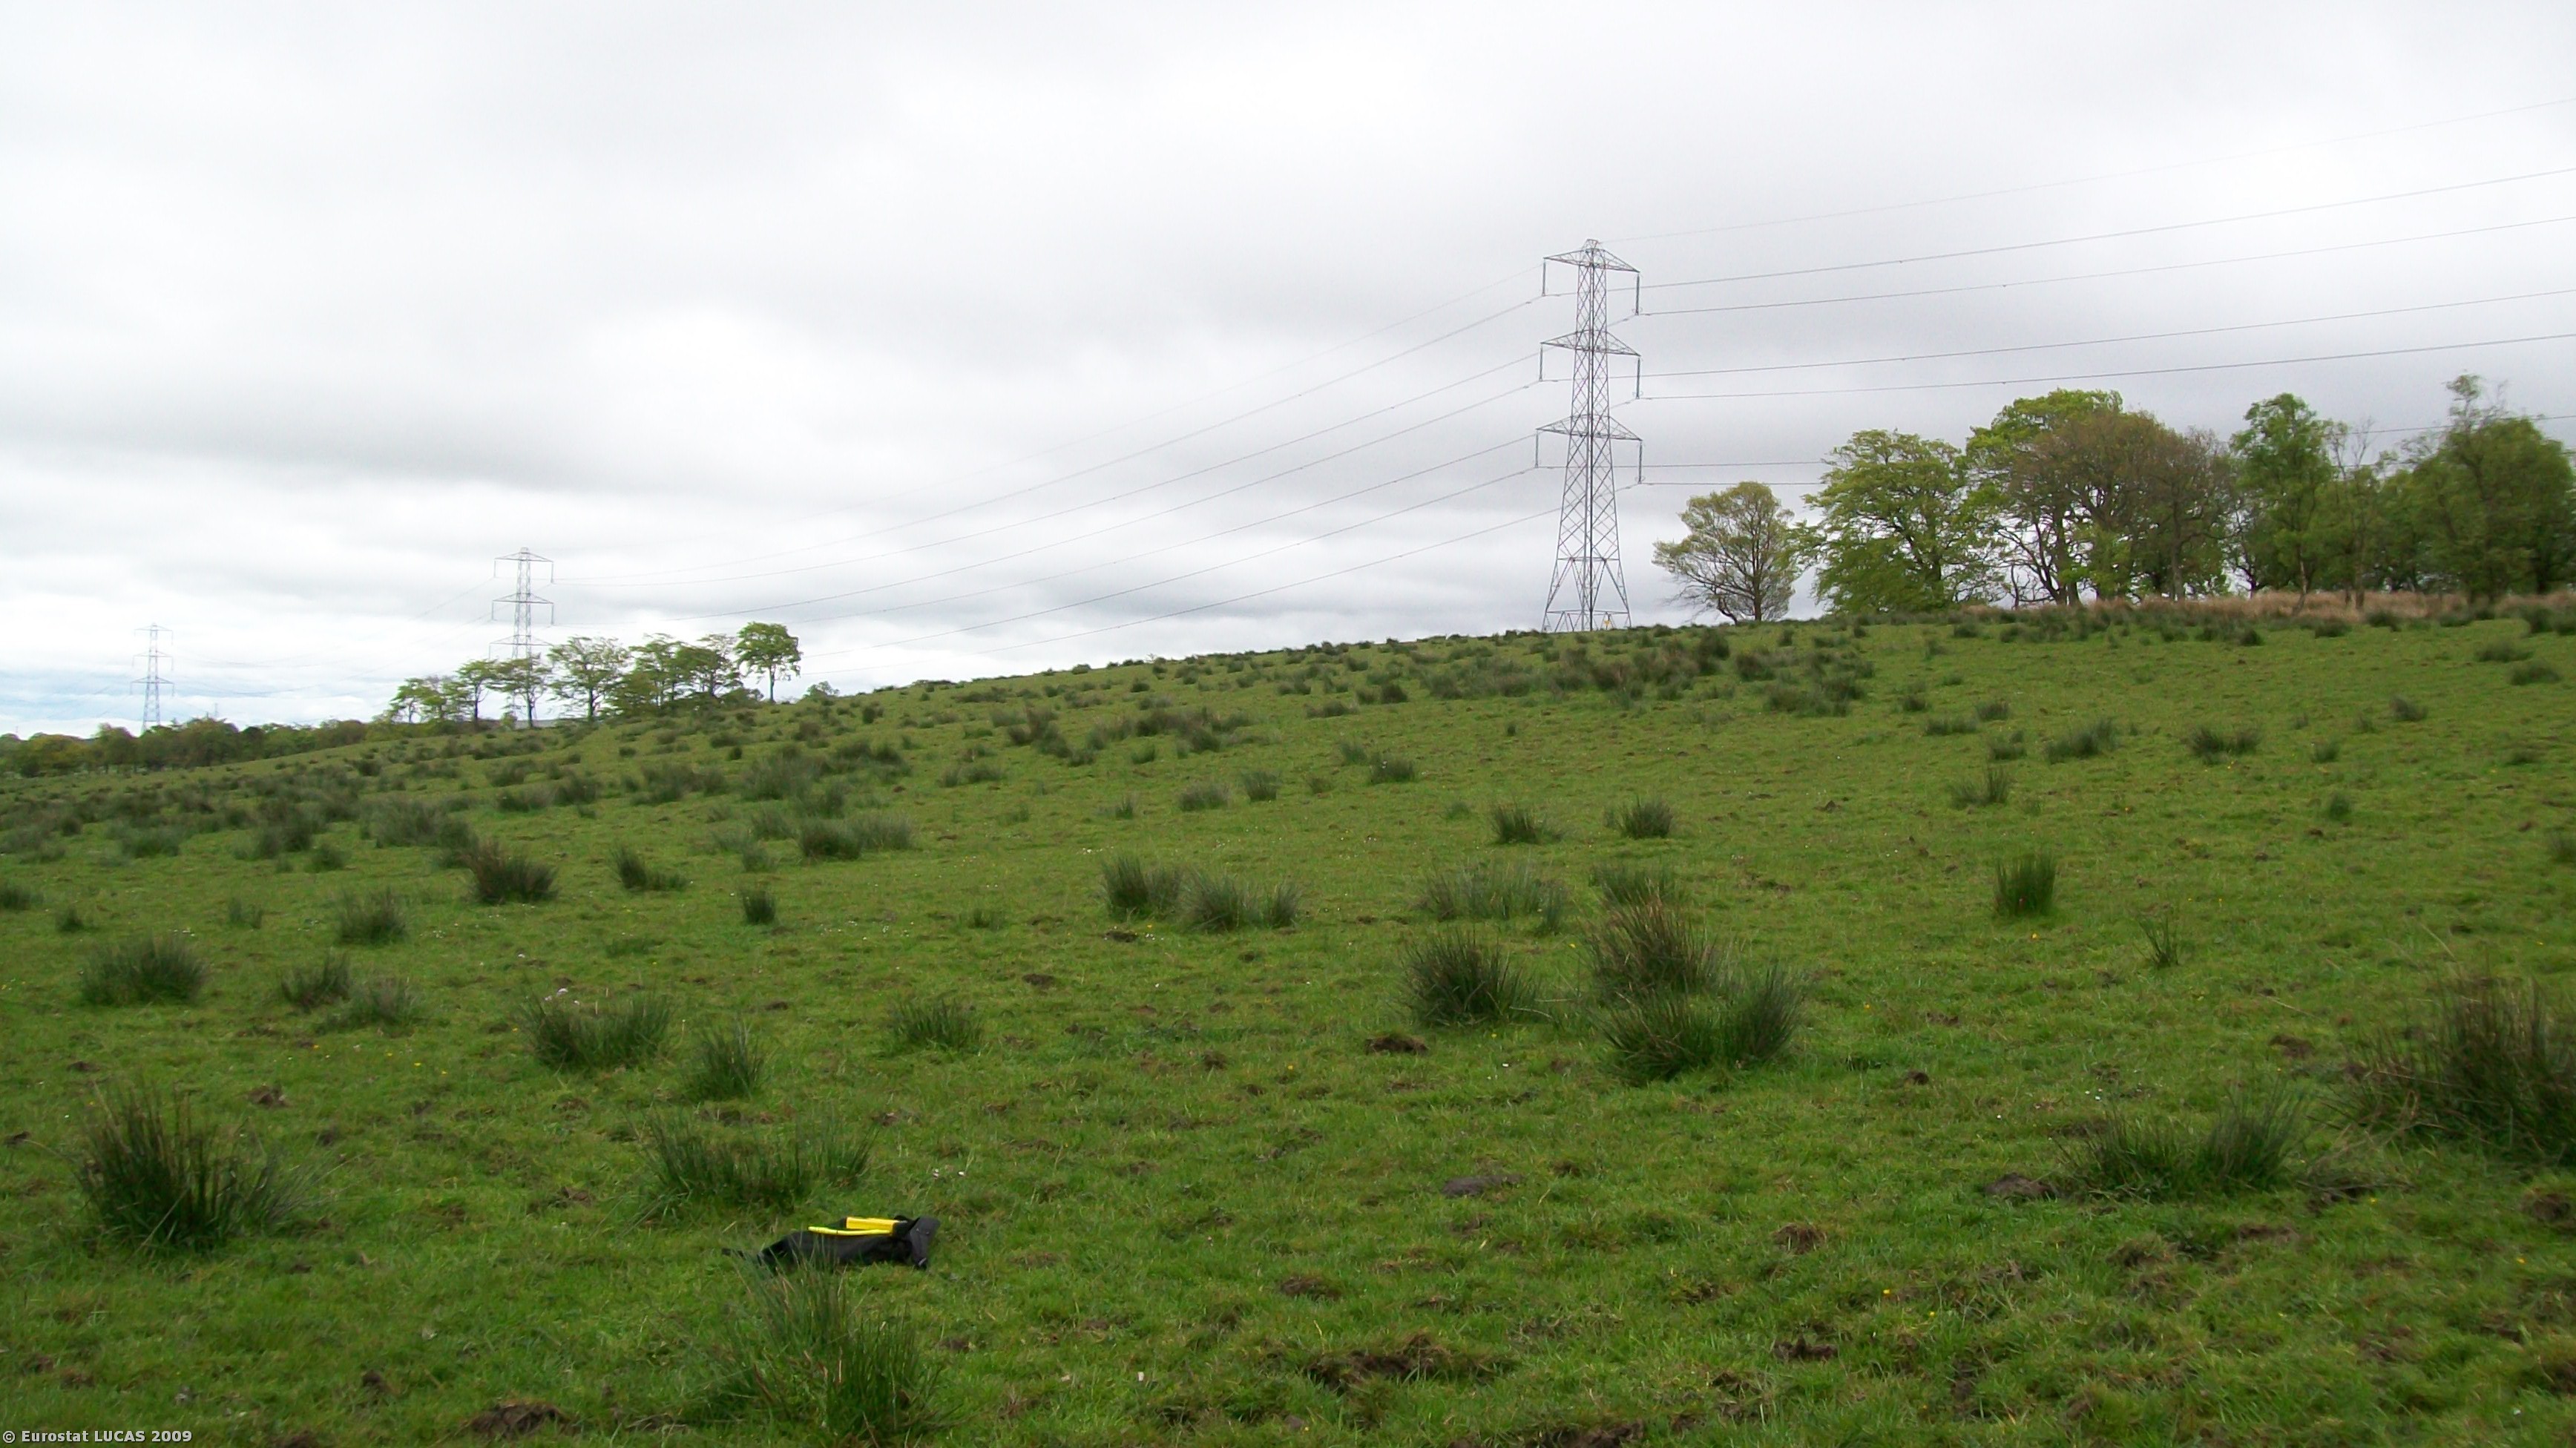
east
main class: Grassland
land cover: Grassland without tree/shrub cover
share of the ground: > 75 %
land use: Agriculture (excluding fallow land and kitchen gardens)
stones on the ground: < 10 %
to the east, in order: Grassland without tree/shrub cover; Ditches and canals; Broadleaved woodland; Fences; Grassland with sparse tree/shrub cover; Ditches and canals; Grassland without tree/shrub cover; Electric lines; Grassland without tree/shrub cover
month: May
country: GB
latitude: 55.8278
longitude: -3.5685
